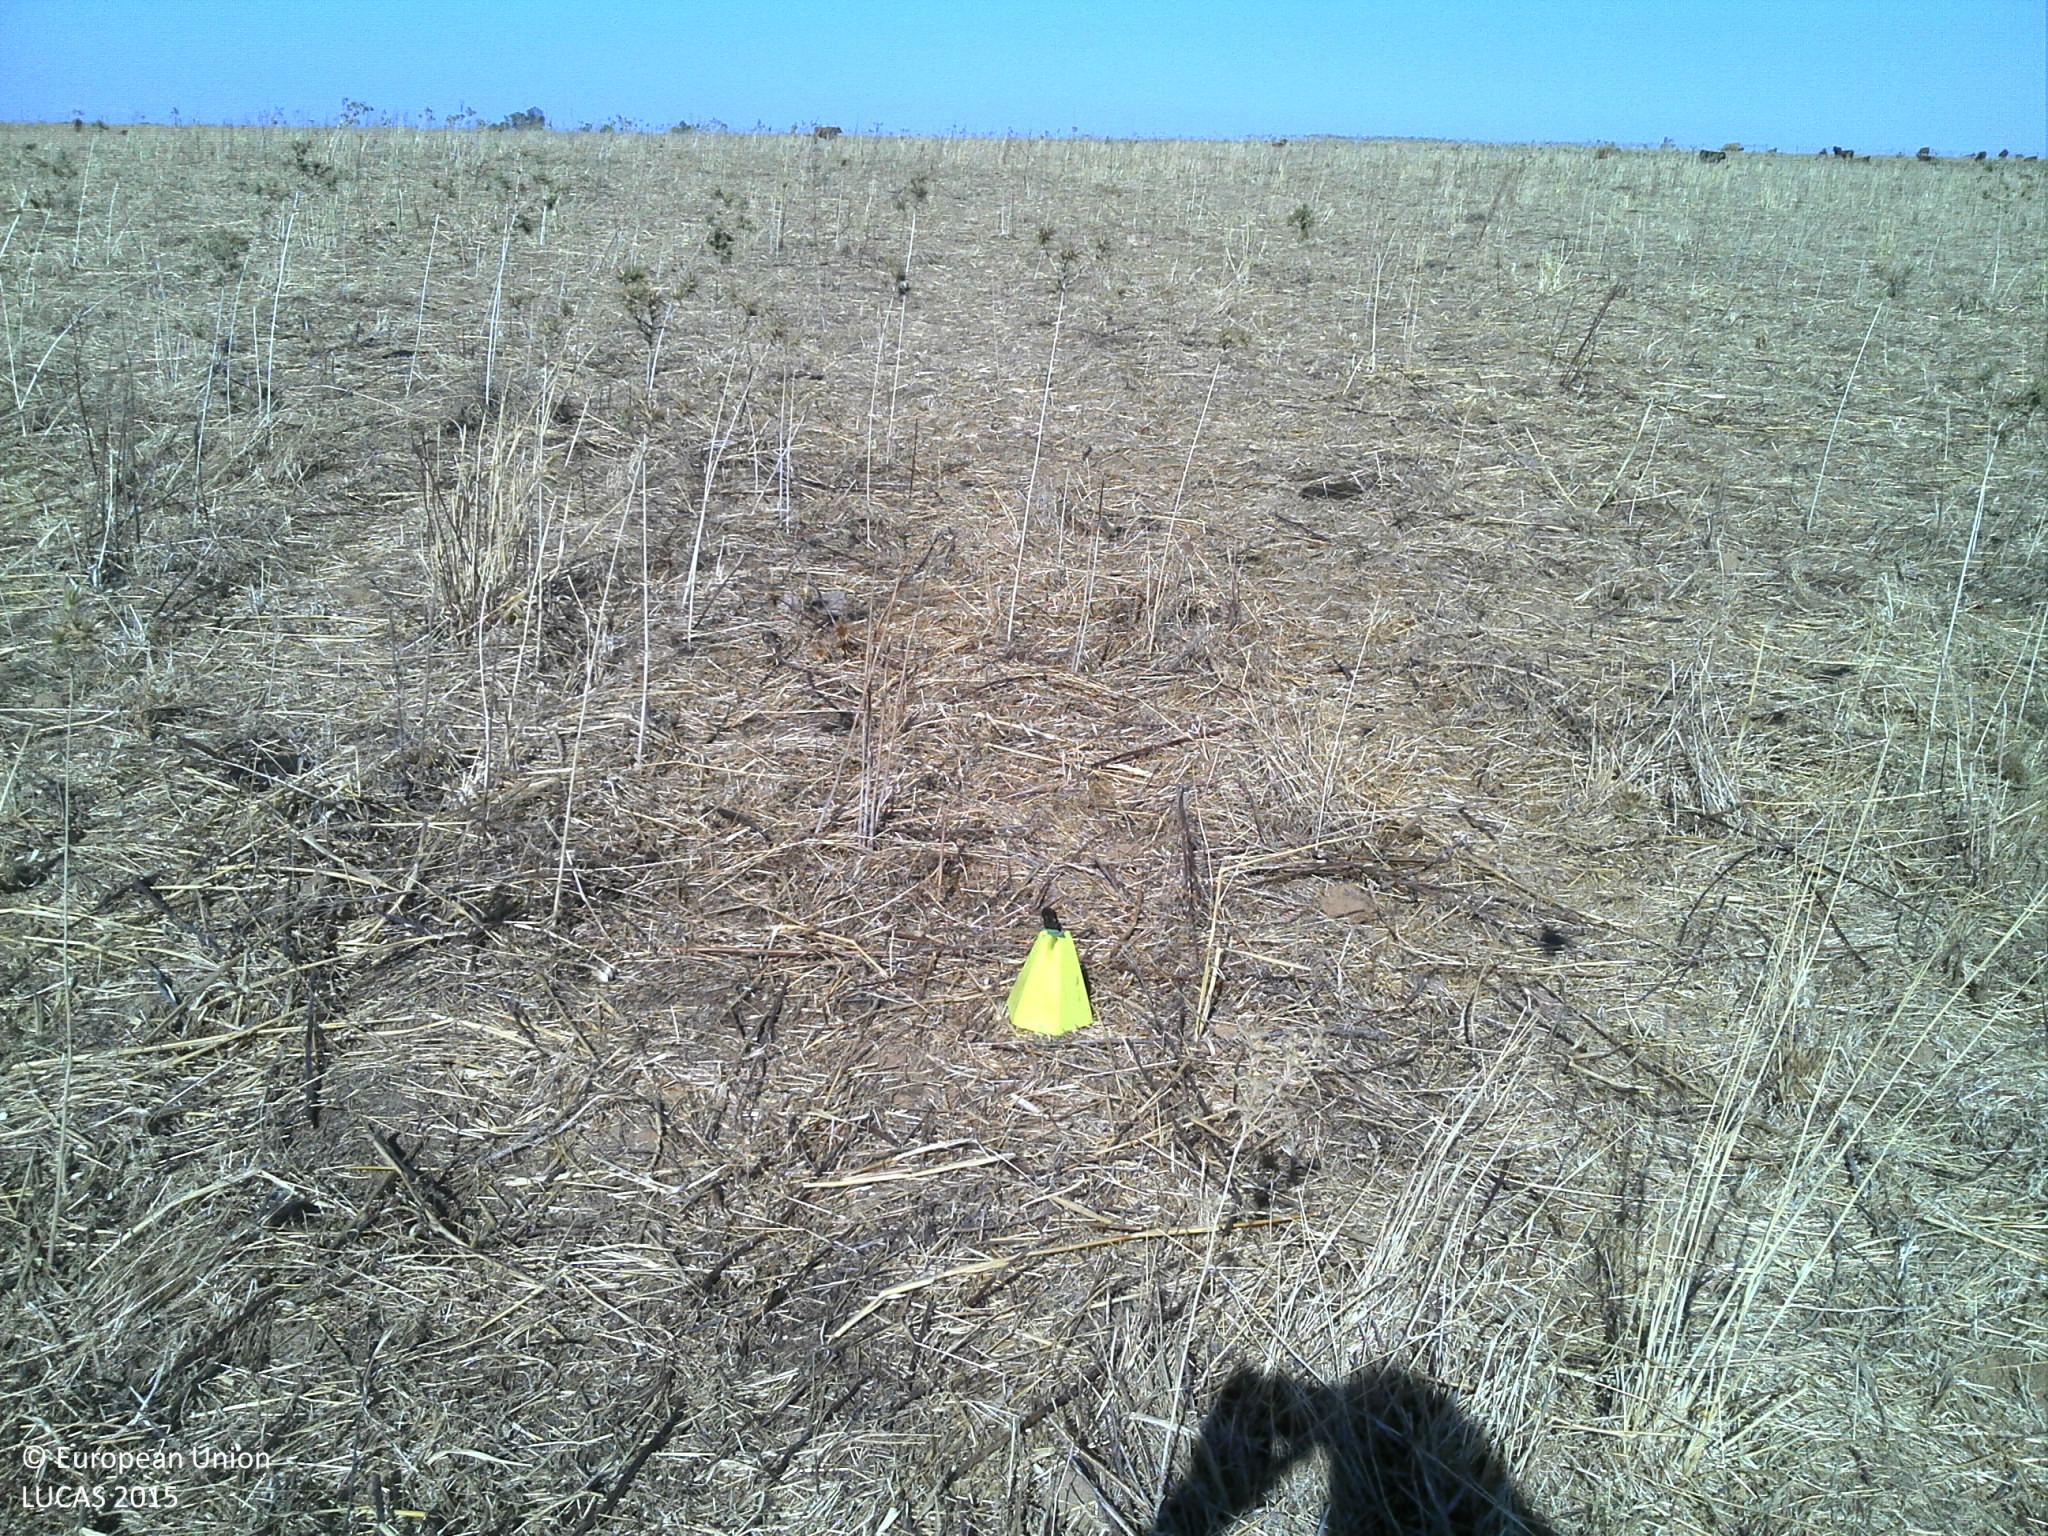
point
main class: Grassland
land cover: Grassland without tree/shrub cover
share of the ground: 10 - 25 %
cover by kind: unconsolidated bare surface 80 %, herbaceous plants 20 %
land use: Agriculture (excluding fallow land and kitchen gardens)
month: July
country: PT
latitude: 38.9799
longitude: -7.4790
